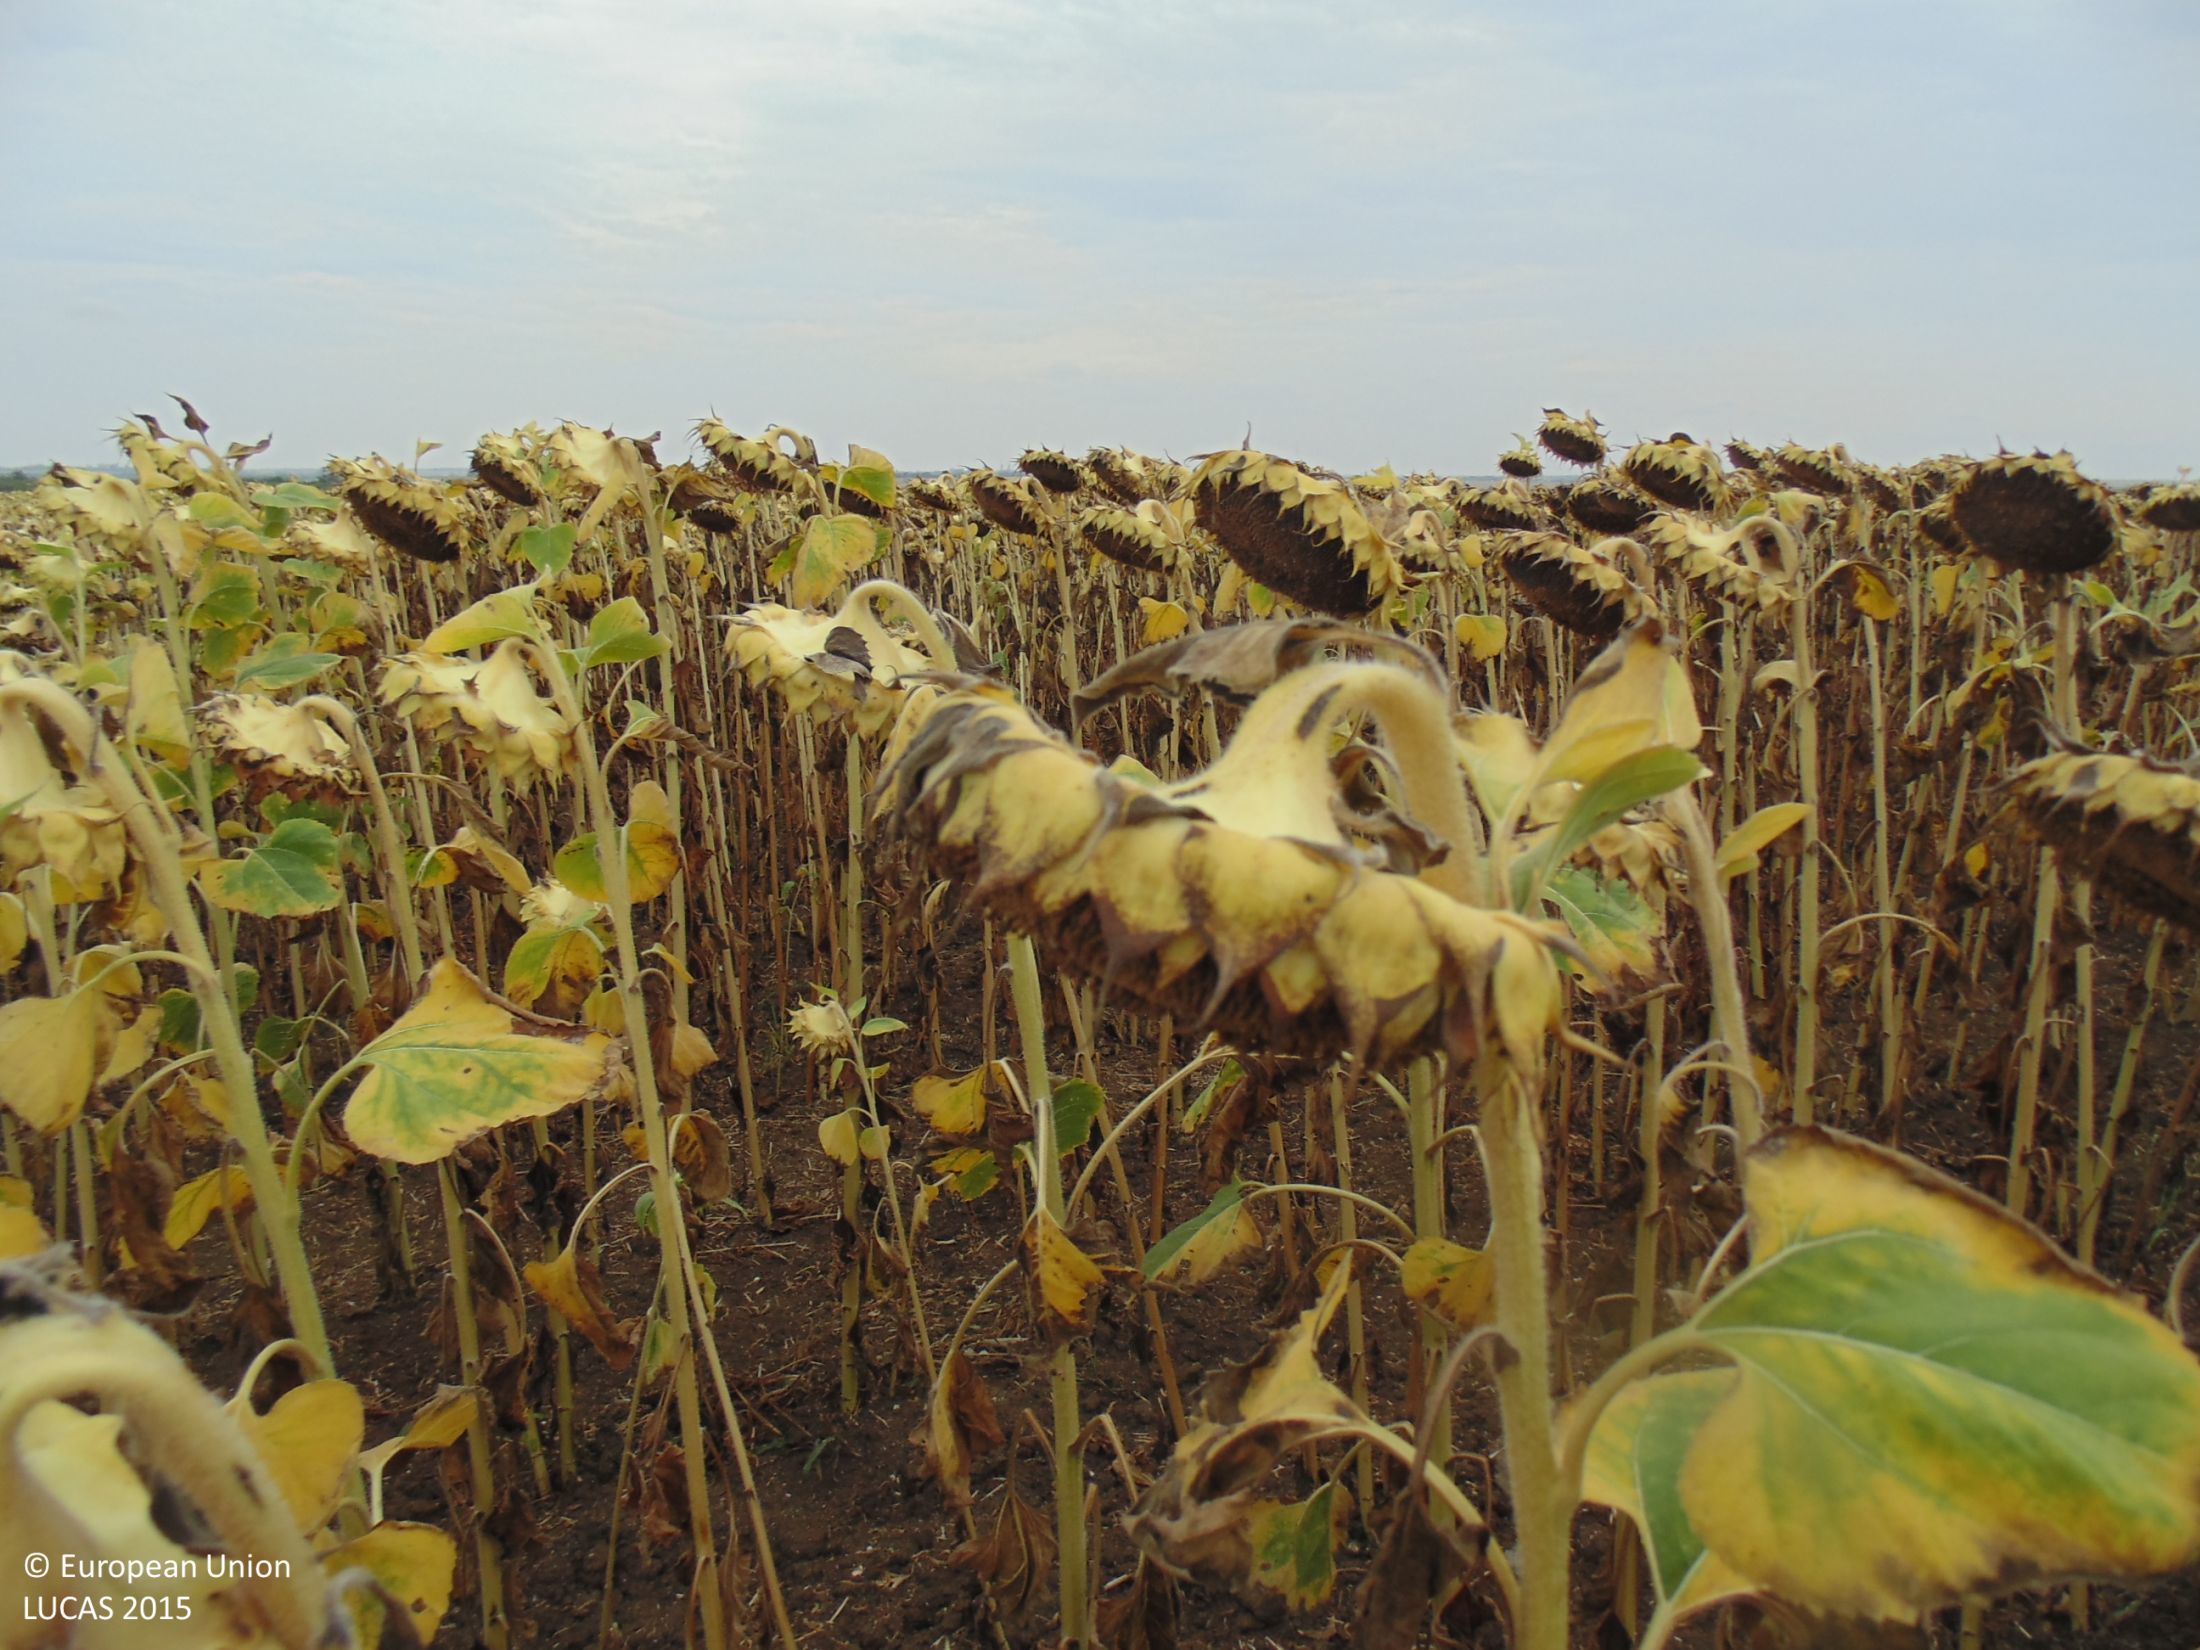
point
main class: Cropland
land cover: Sunflower
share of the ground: > 75 %
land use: Agriculture (excluding fallow land and kitchen gardens)
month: August
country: BG
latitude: 43.5999
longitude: 28.5603
